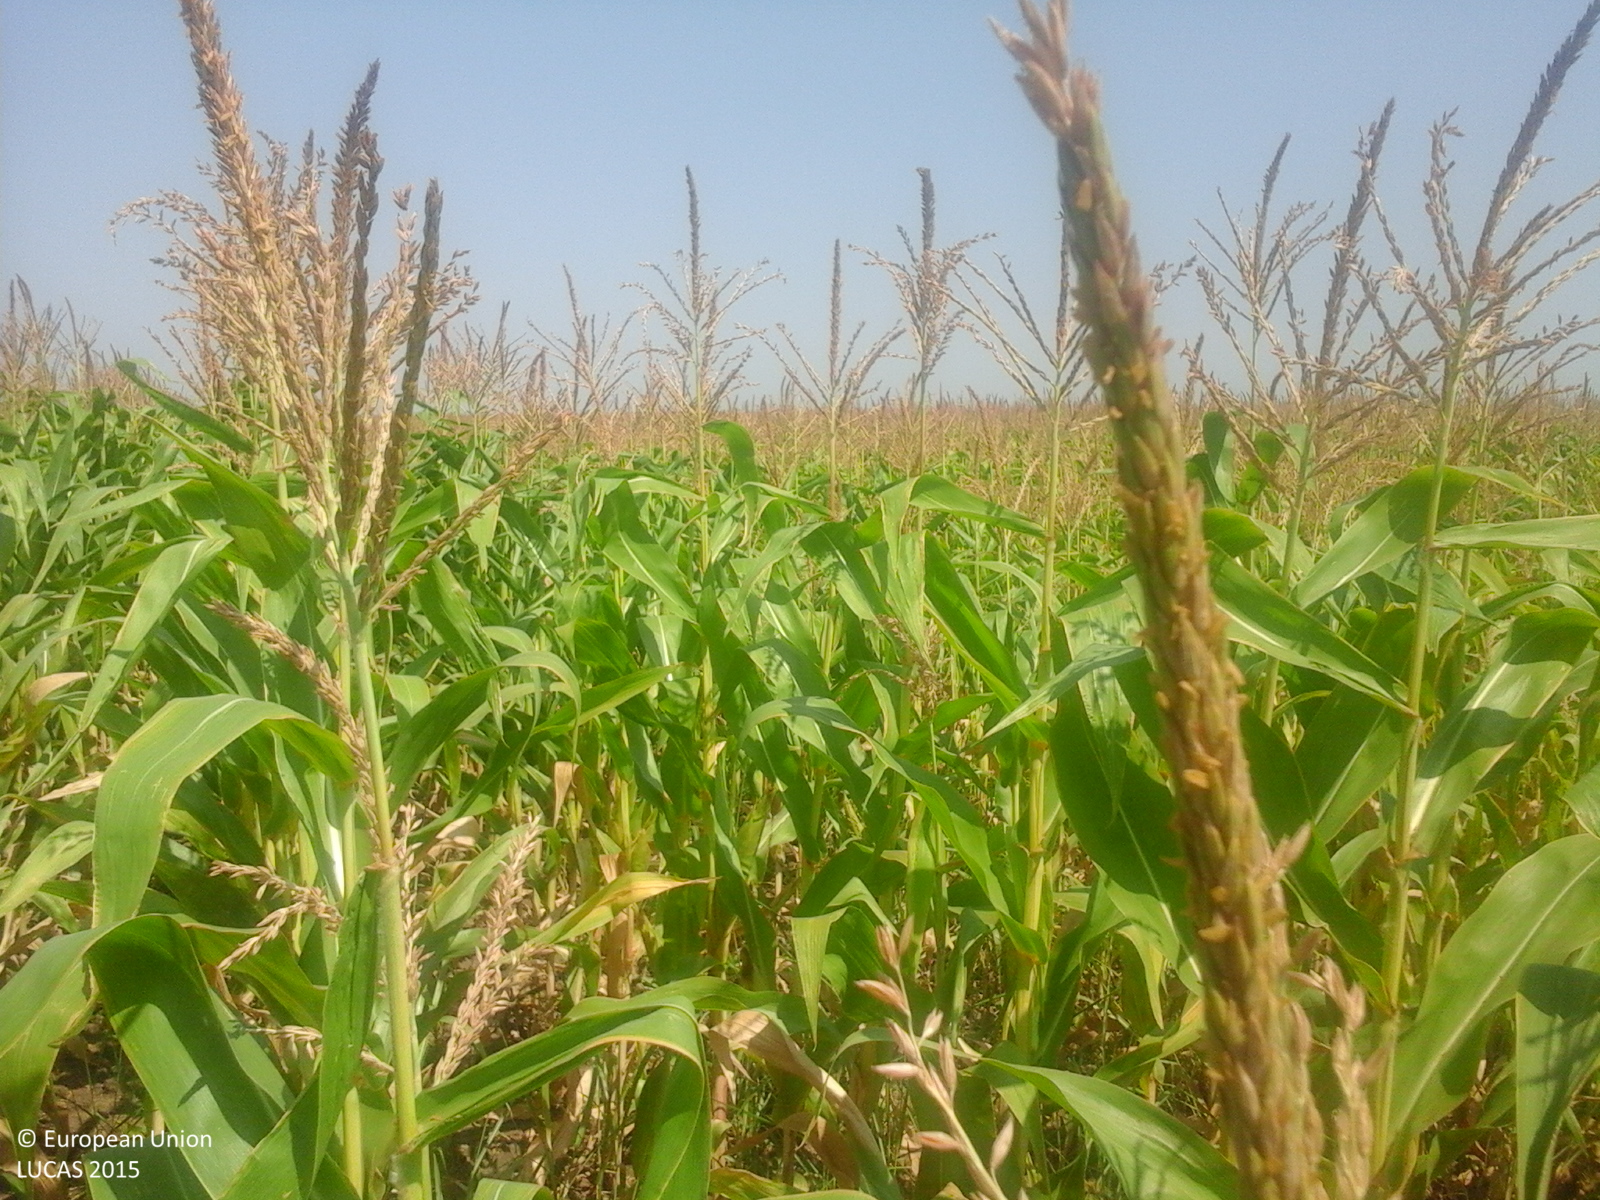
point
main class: Cropland
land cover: Maize
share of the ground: > 75 %
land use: Agriculture (excluding fallow land and kitchen gardens)
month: August
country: RO
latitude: 45.1814
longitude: 27.7582
